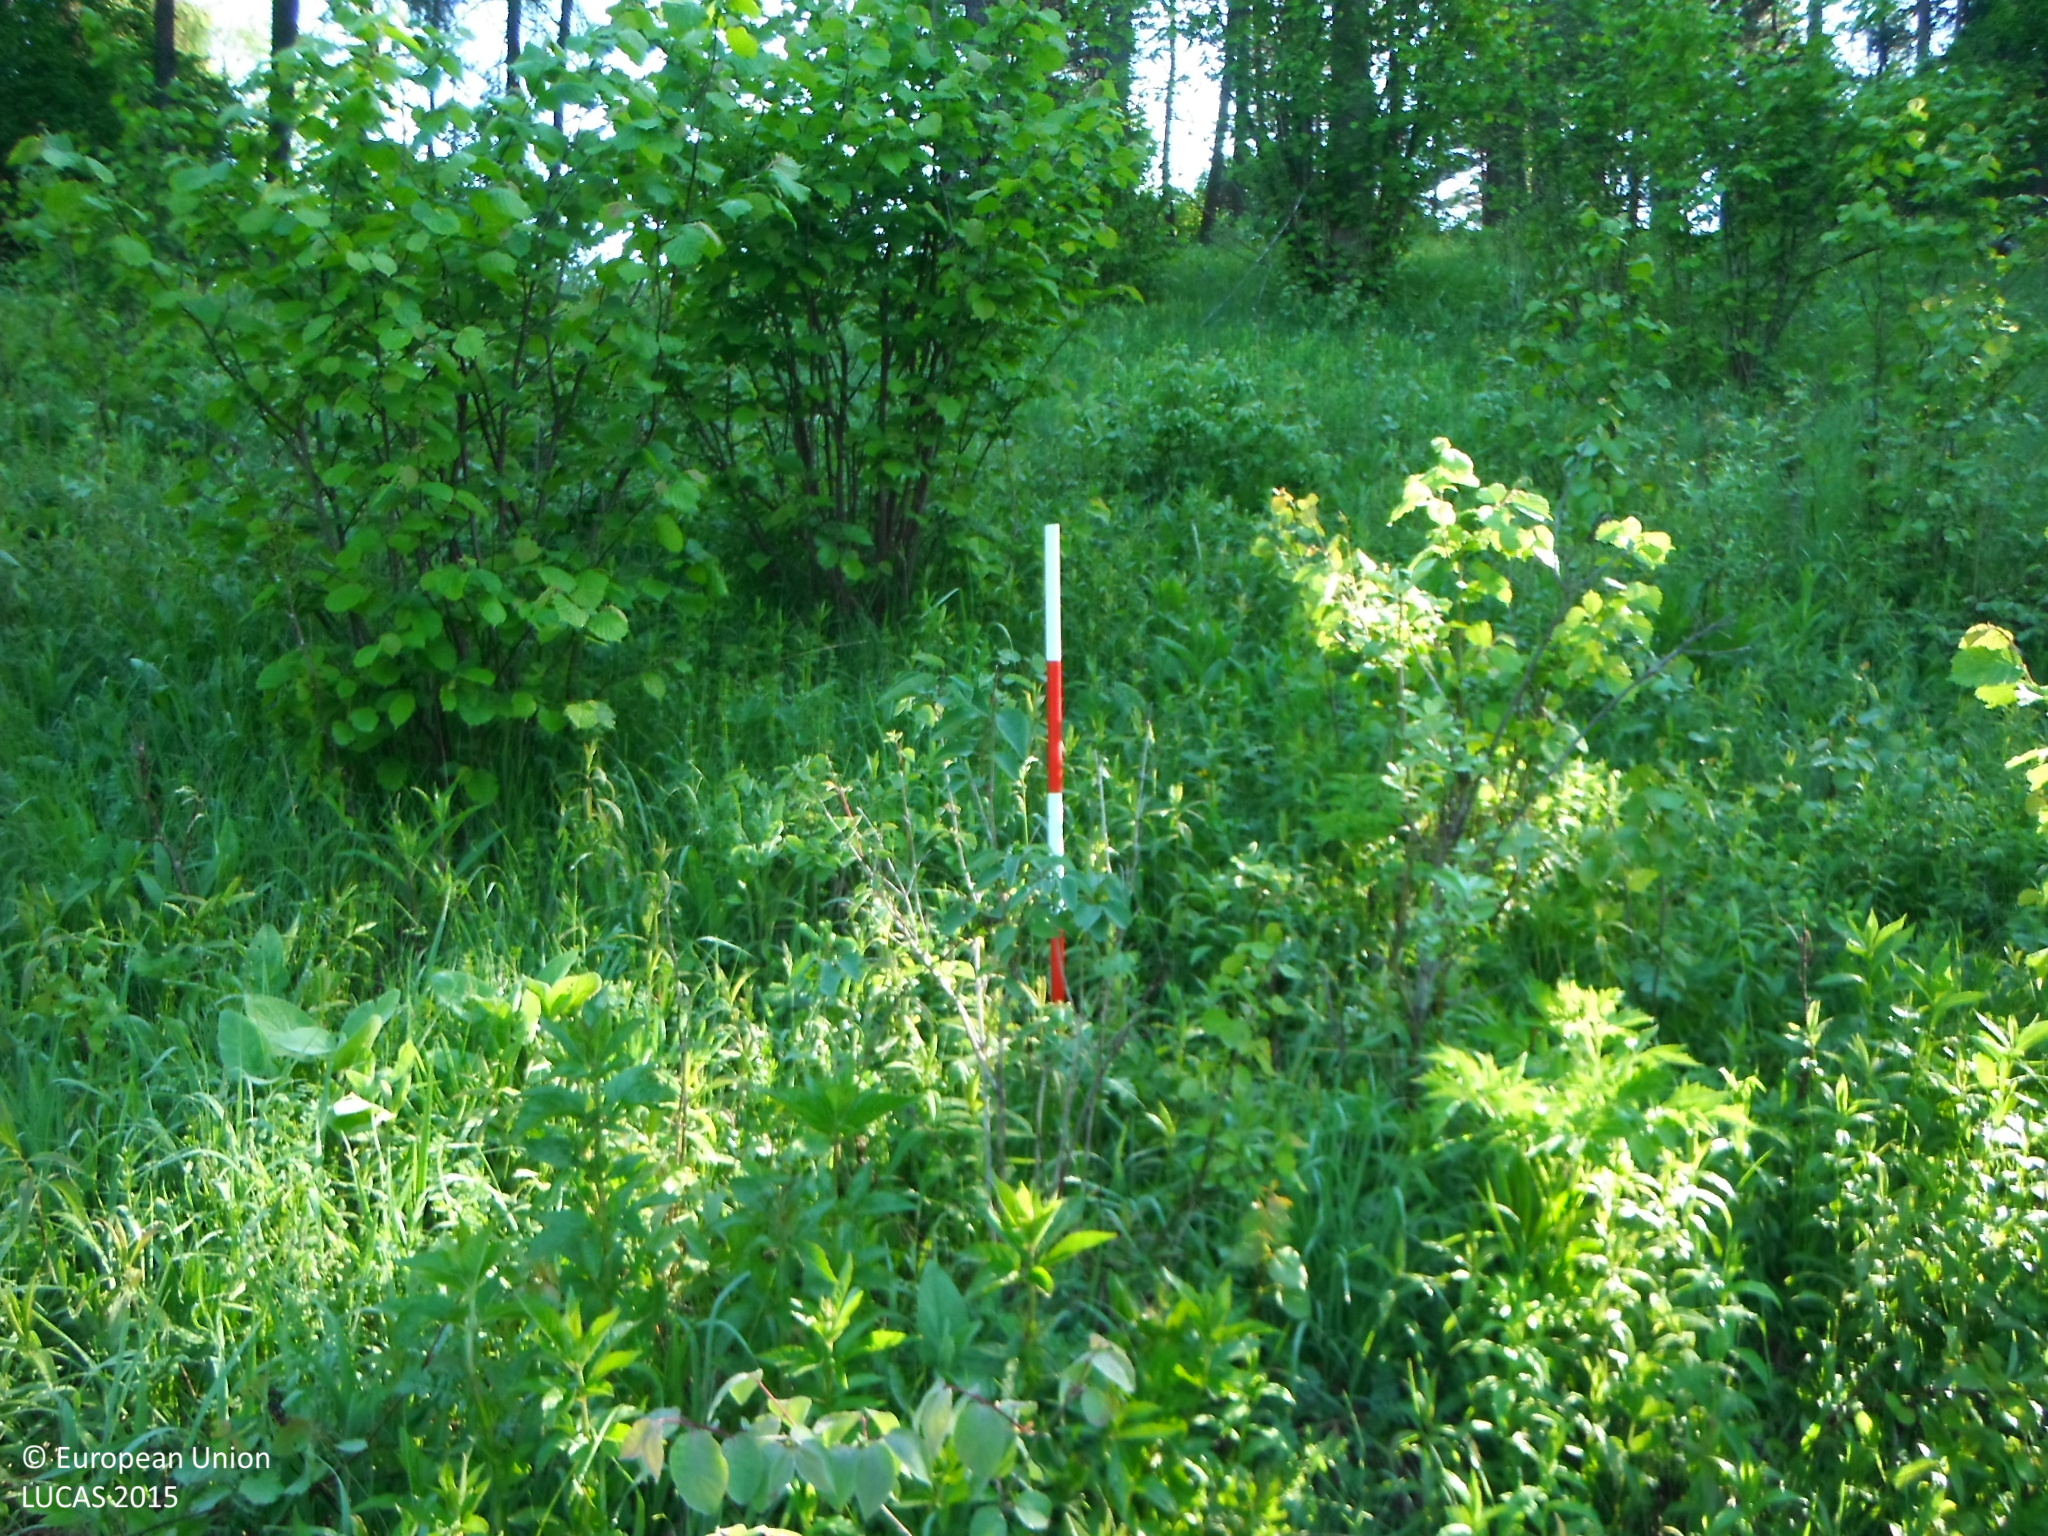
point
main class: Shrubland
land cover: Shrubland with sparse tree cover
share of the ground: > 75 %
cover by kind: shrubs 60 %, herbaceous plants 35 %, coniferous forest trees 5 %
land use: Forestry
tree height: > 5 m
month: June
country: SK
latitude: 49.0591
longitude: 19.9520
